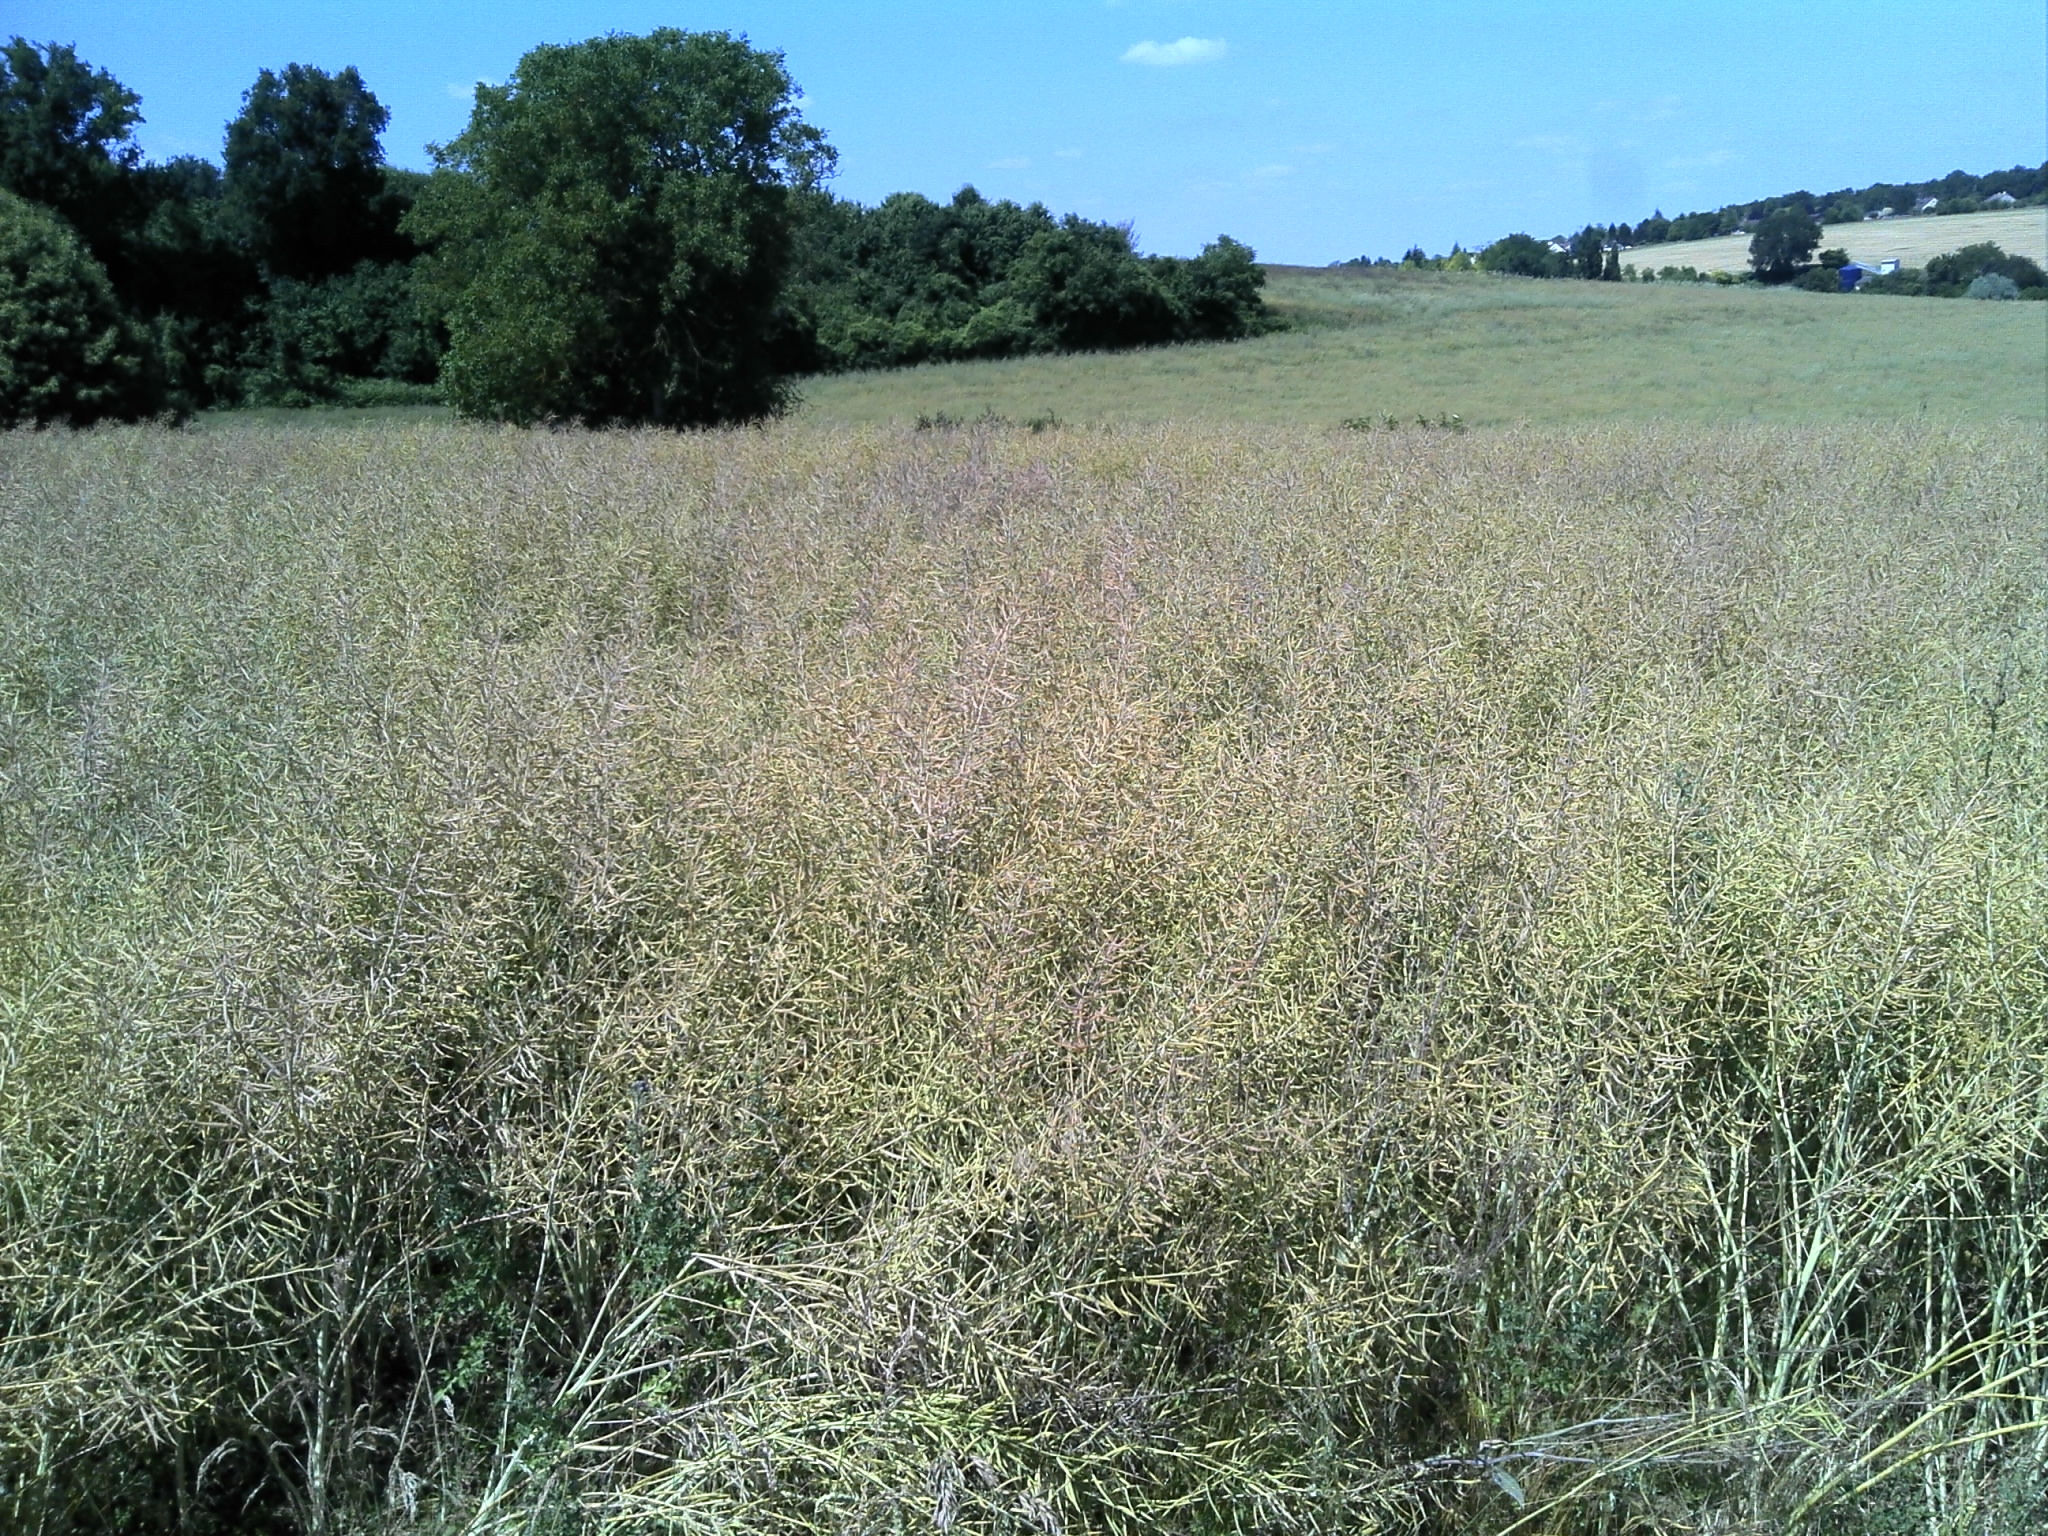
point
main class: Cropland
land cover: Rape and turnip rape
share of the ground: > 75 %
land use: Agriculture (excluding fallow land and kitchen gardens)
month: June
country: FR
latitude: 47.1115
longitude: 1.4342
